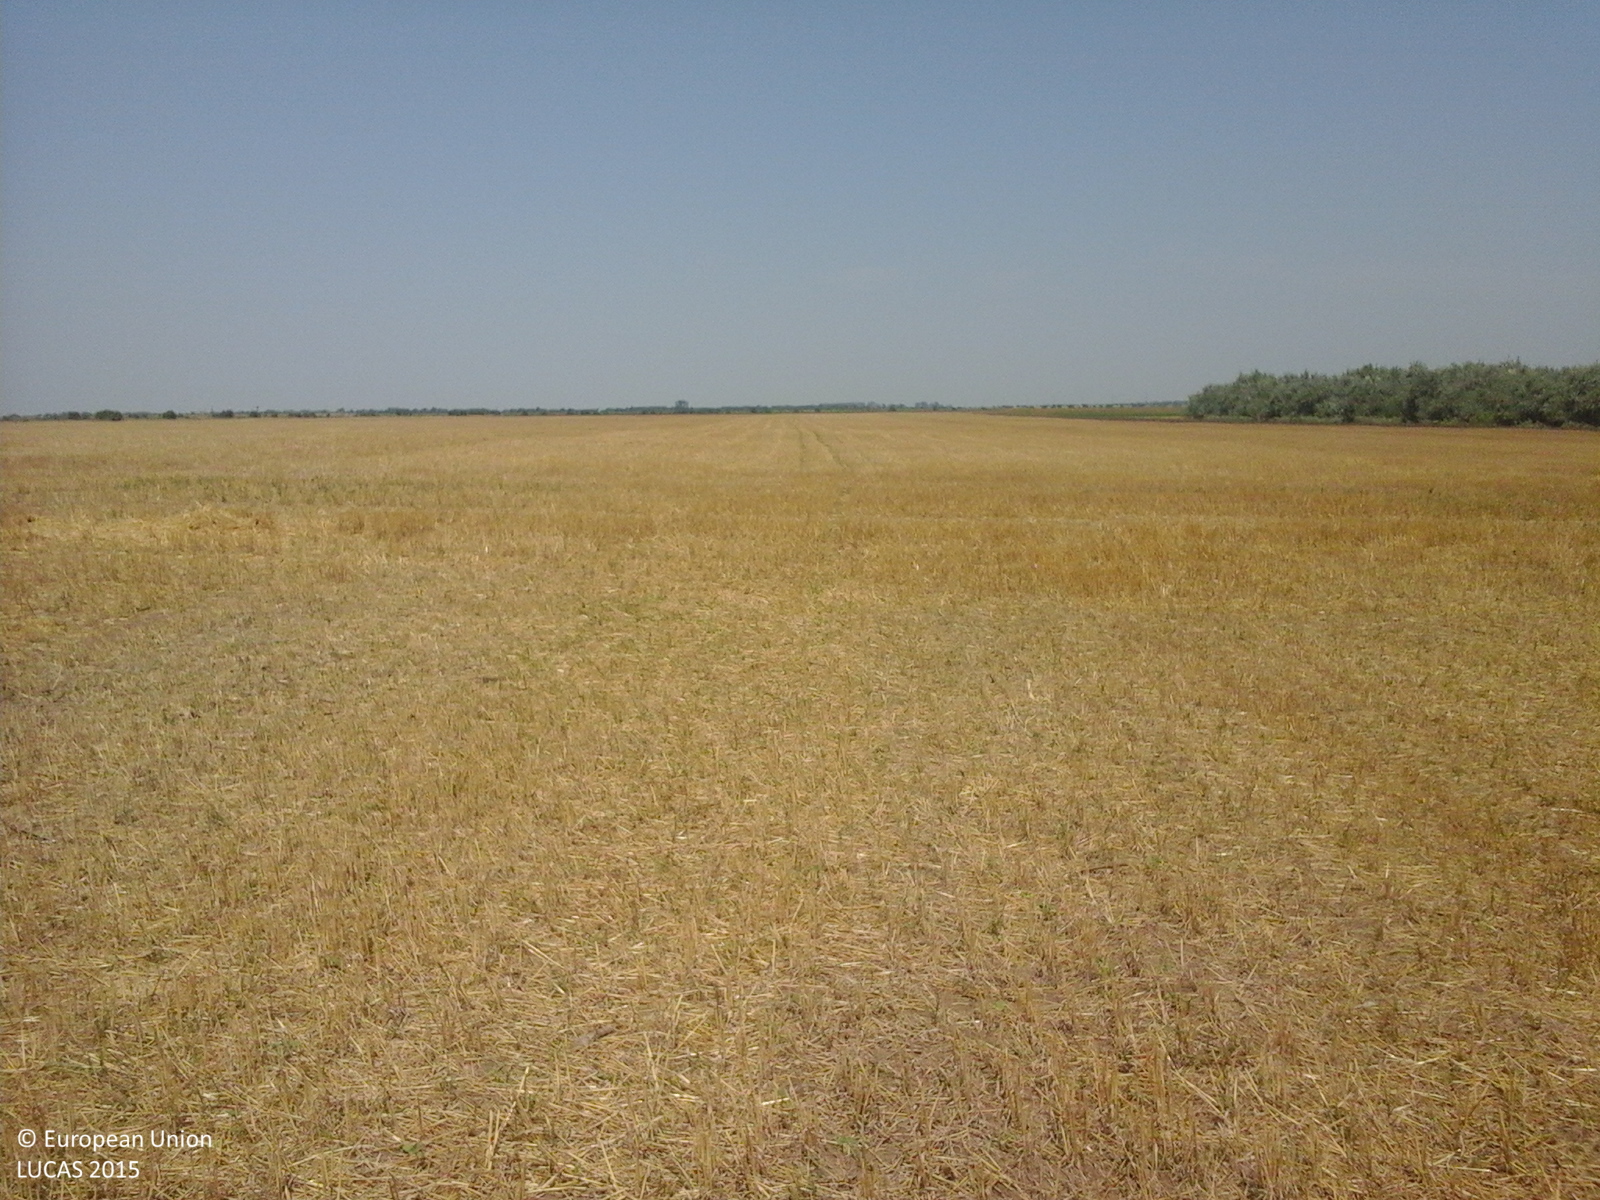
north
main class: Cropland
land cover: Common wheat
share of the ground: 25 - 50 %
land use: Agriculture (excluding fallow land and kitchen gardens)
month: August
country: RO
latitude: 45.2078
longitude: 27.8194
